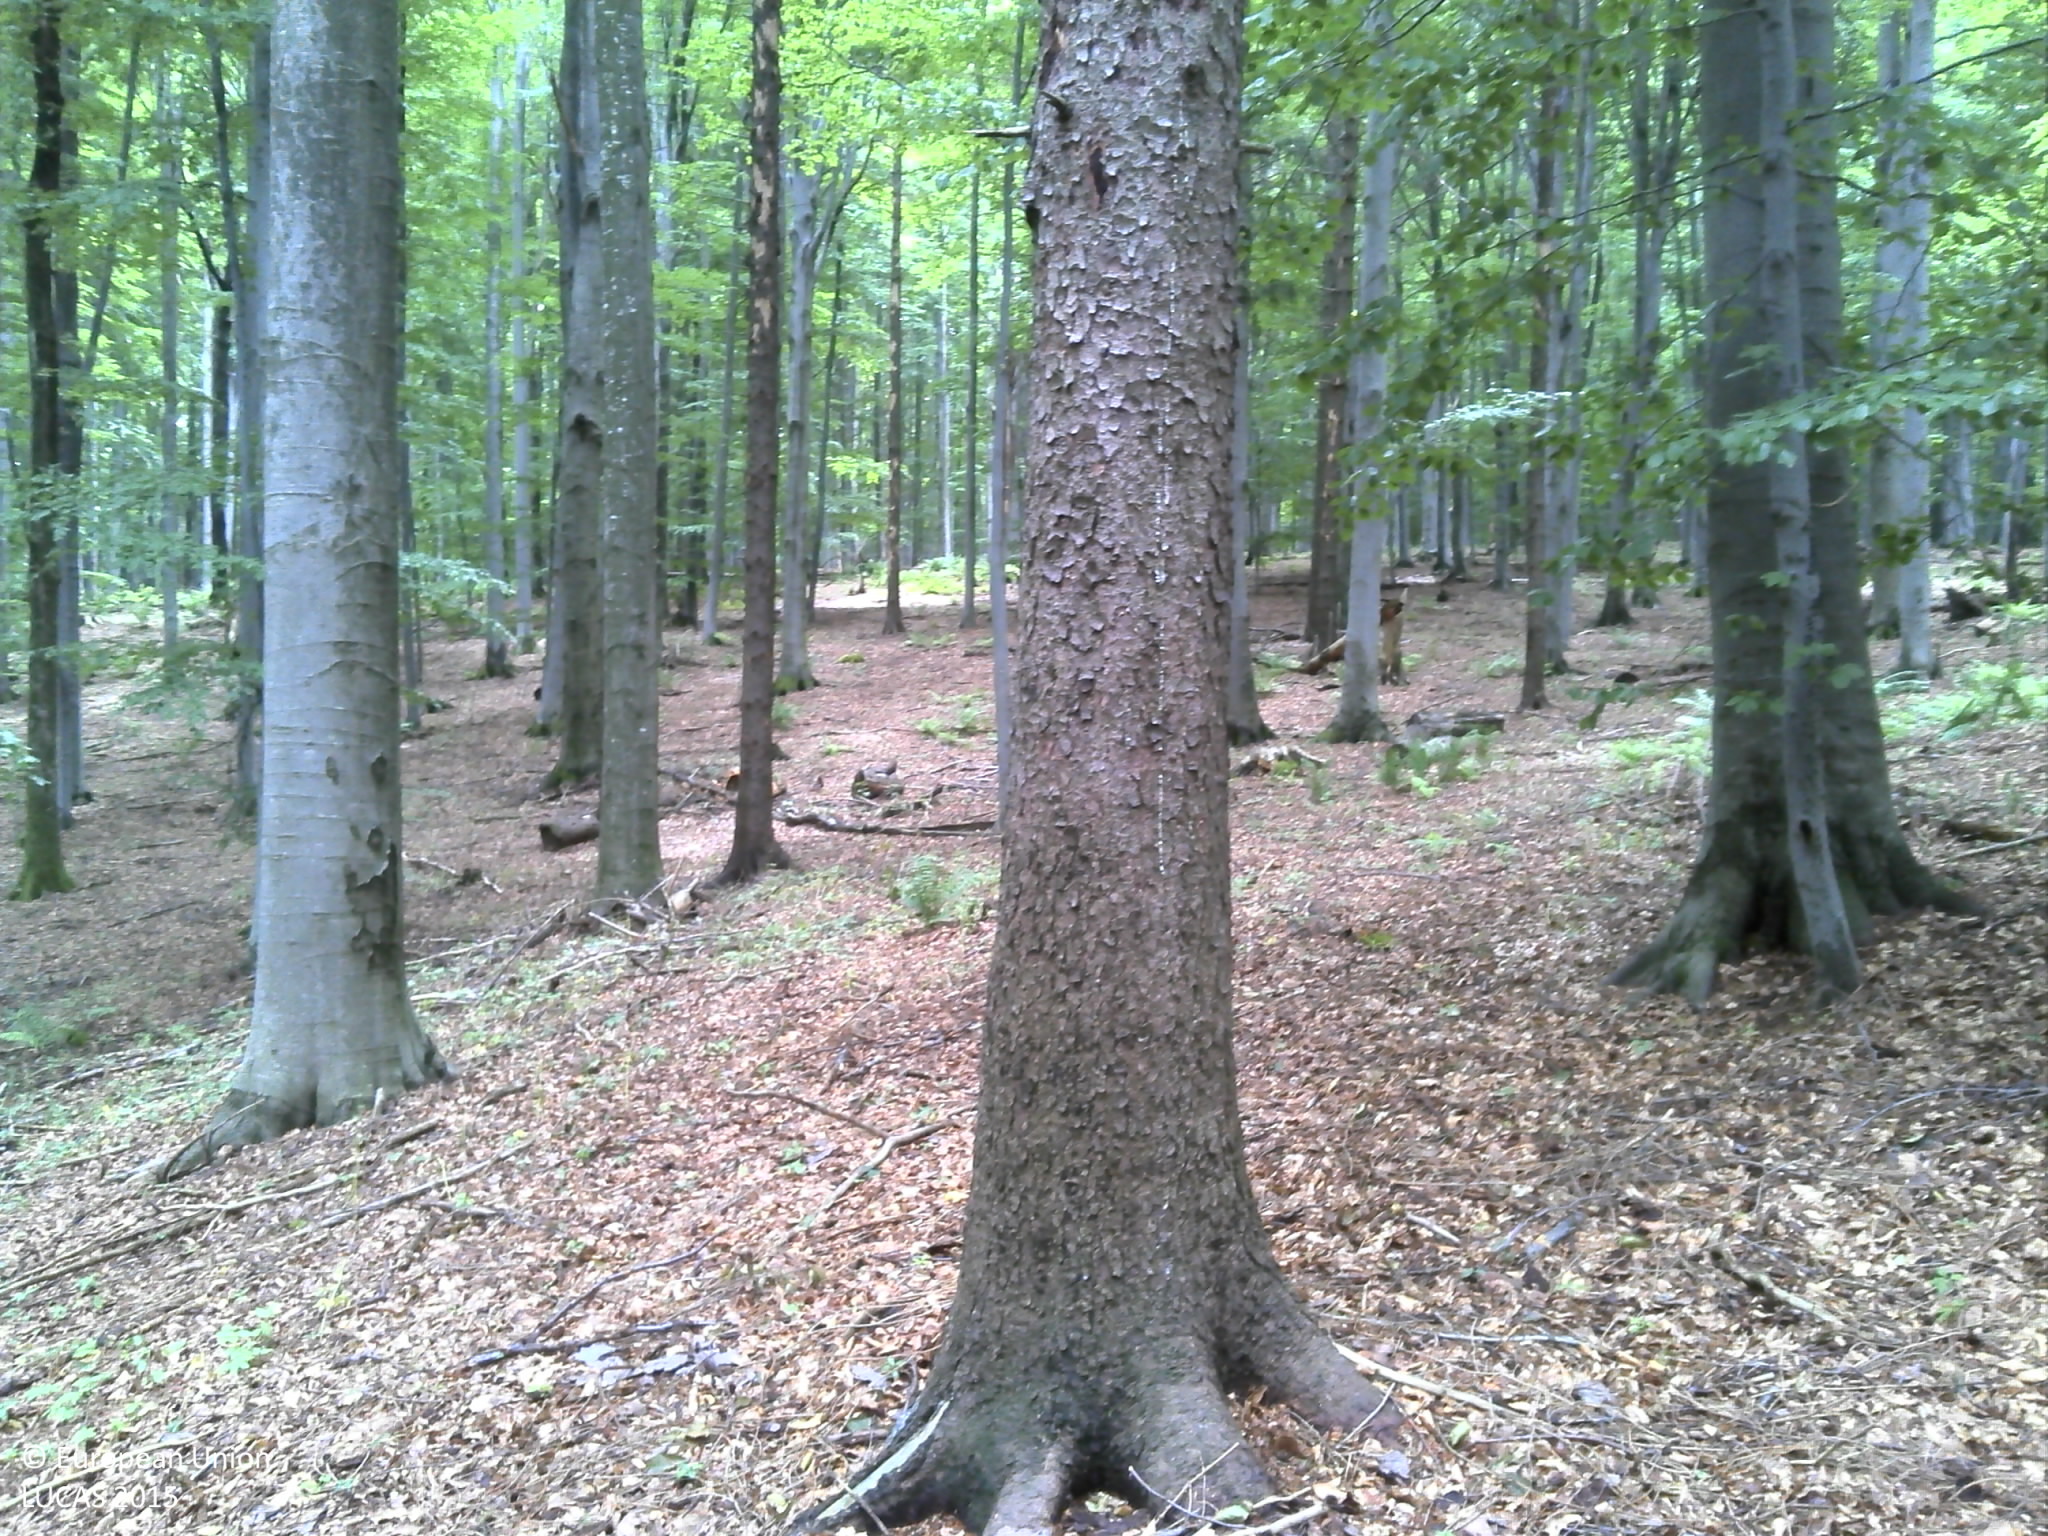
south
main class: Woodland
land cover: Other mixed woodland
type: beech forest
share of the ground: > 75 %
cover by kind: broadleaved forest trees 60 %, coniferous forest trees 40 %
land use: Forestry
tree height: > 5 m
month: June
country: HR
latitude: 45.5132
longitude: 17.4385
